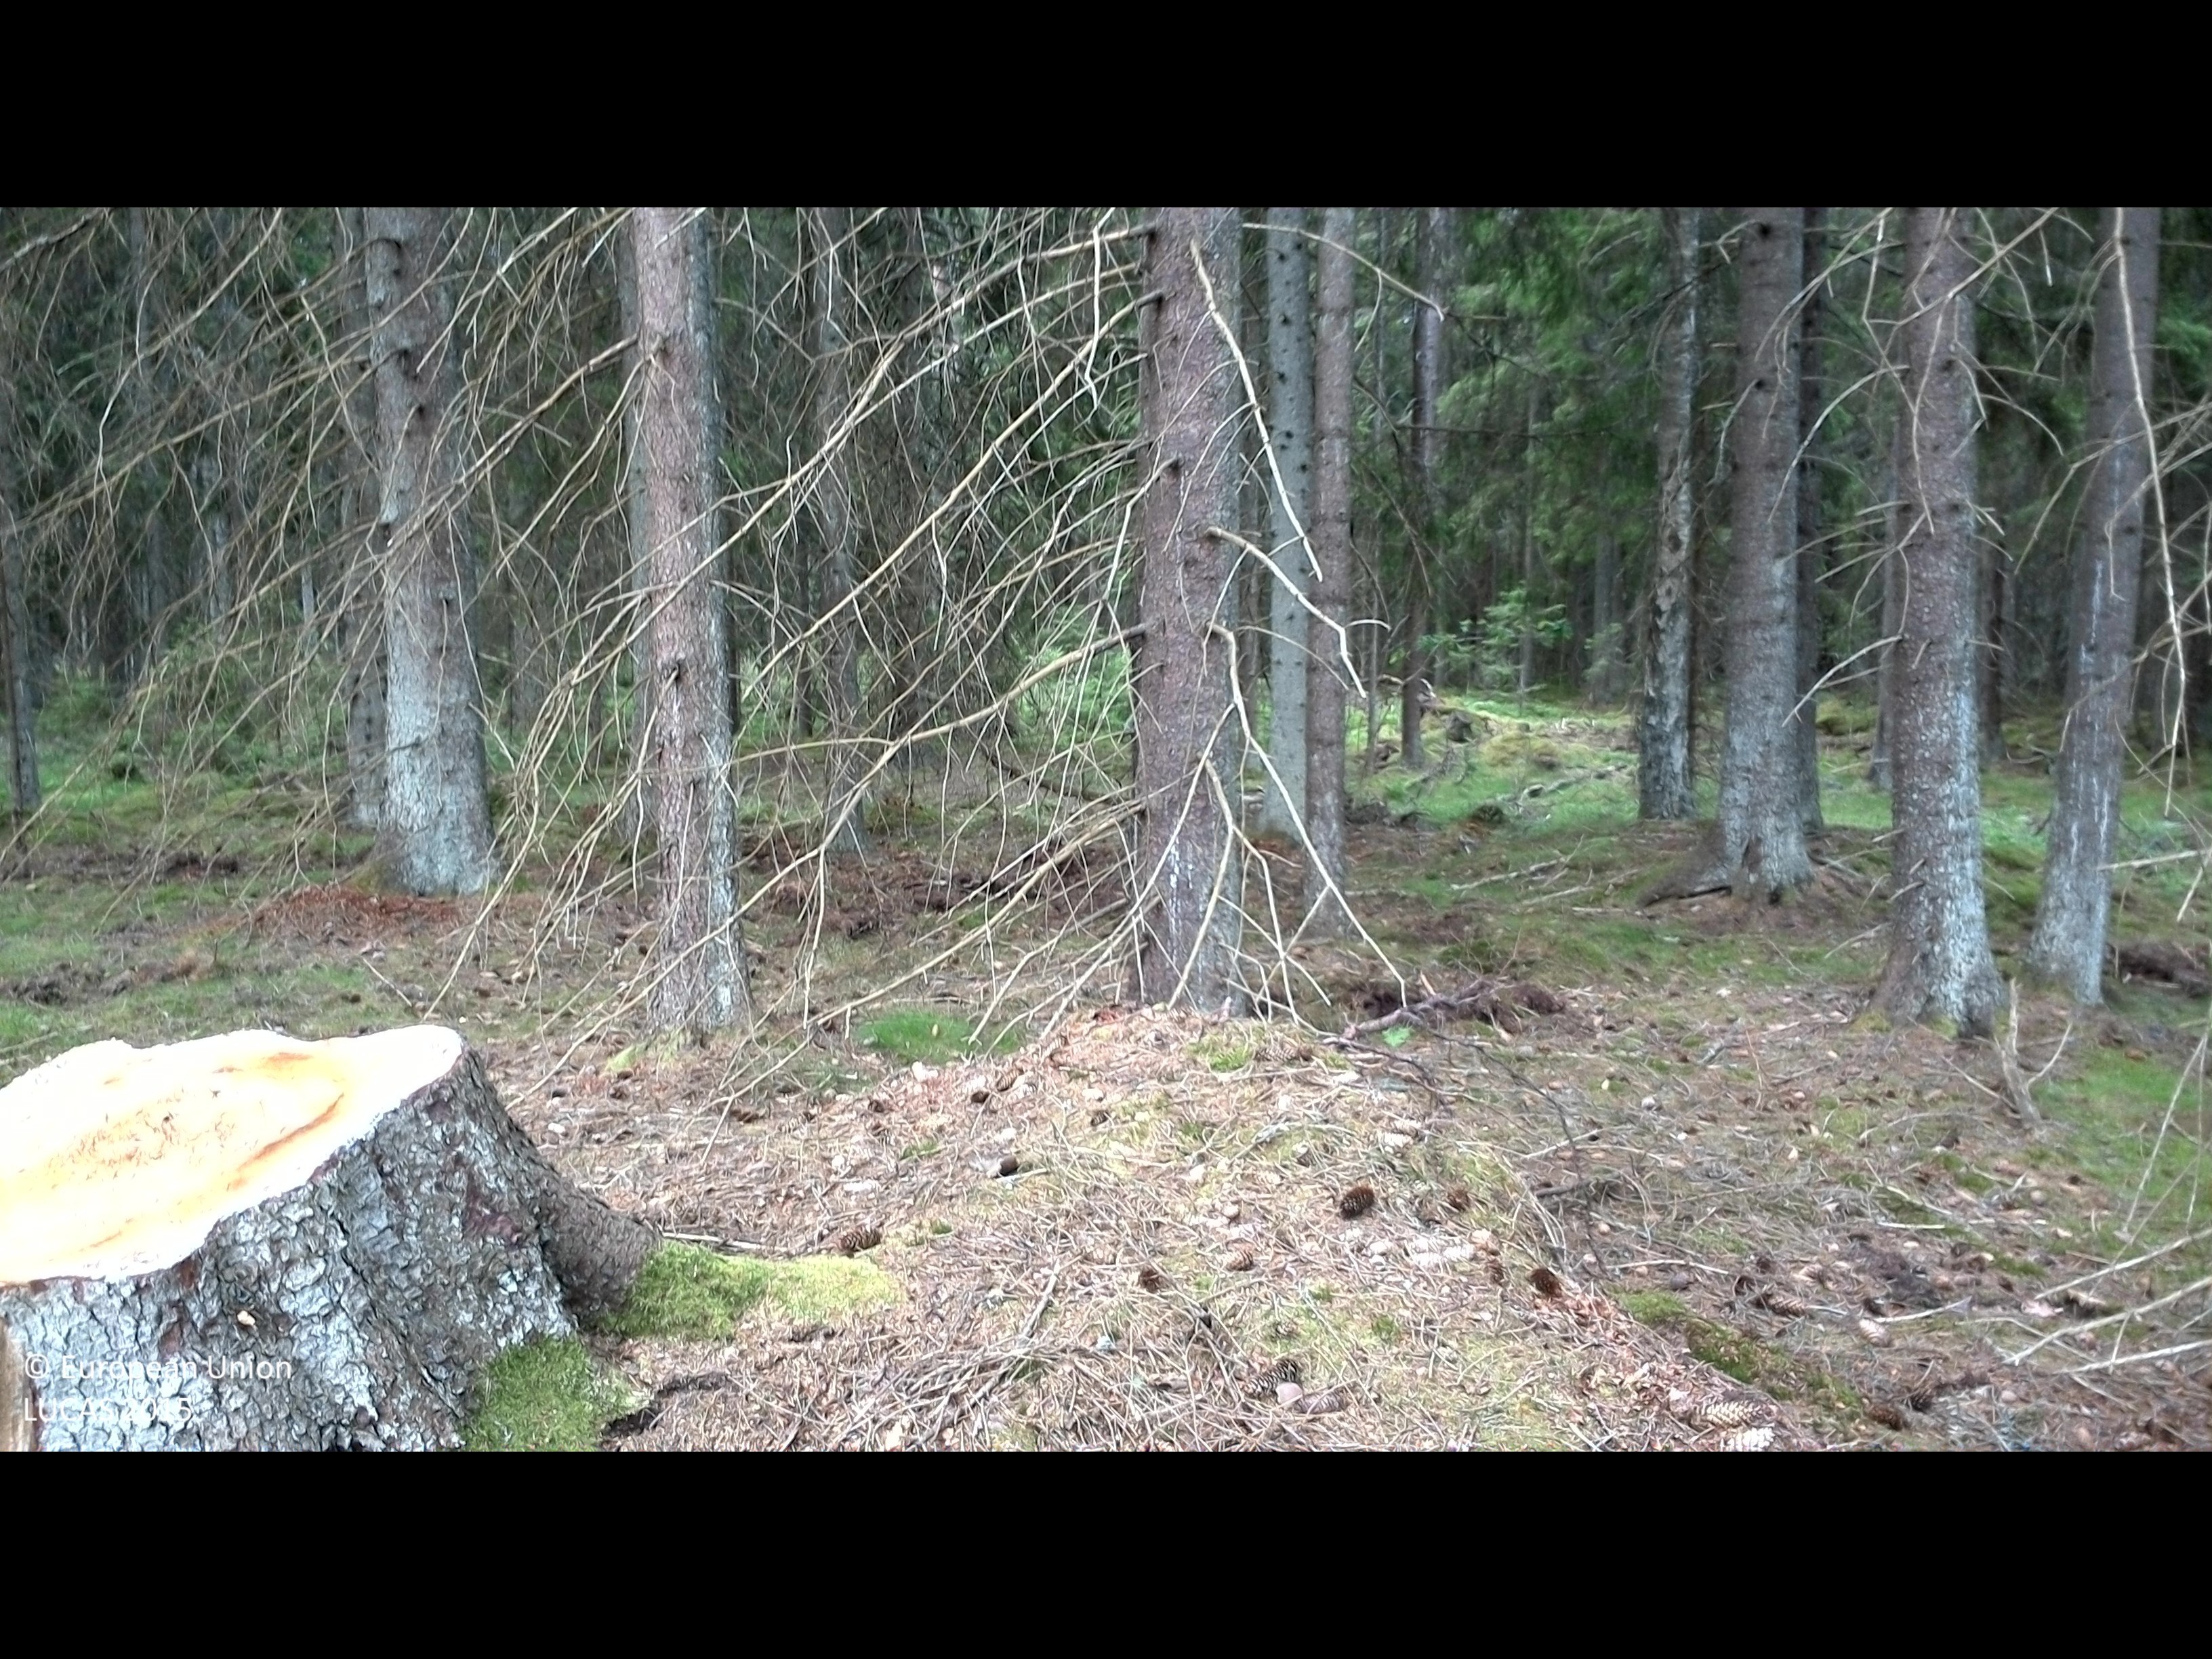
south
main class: Woodland
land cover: Spruce dominated coniferous woodland
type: boreal forest
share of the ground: 50 - 75 %
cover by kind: coniferous forest trees 70 %, lichens and mosses 25 %, herbaceous plants 5 %
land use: Forestry
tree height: > 5 m
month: July
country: SE
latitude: 56.5150
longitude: 14.7270
